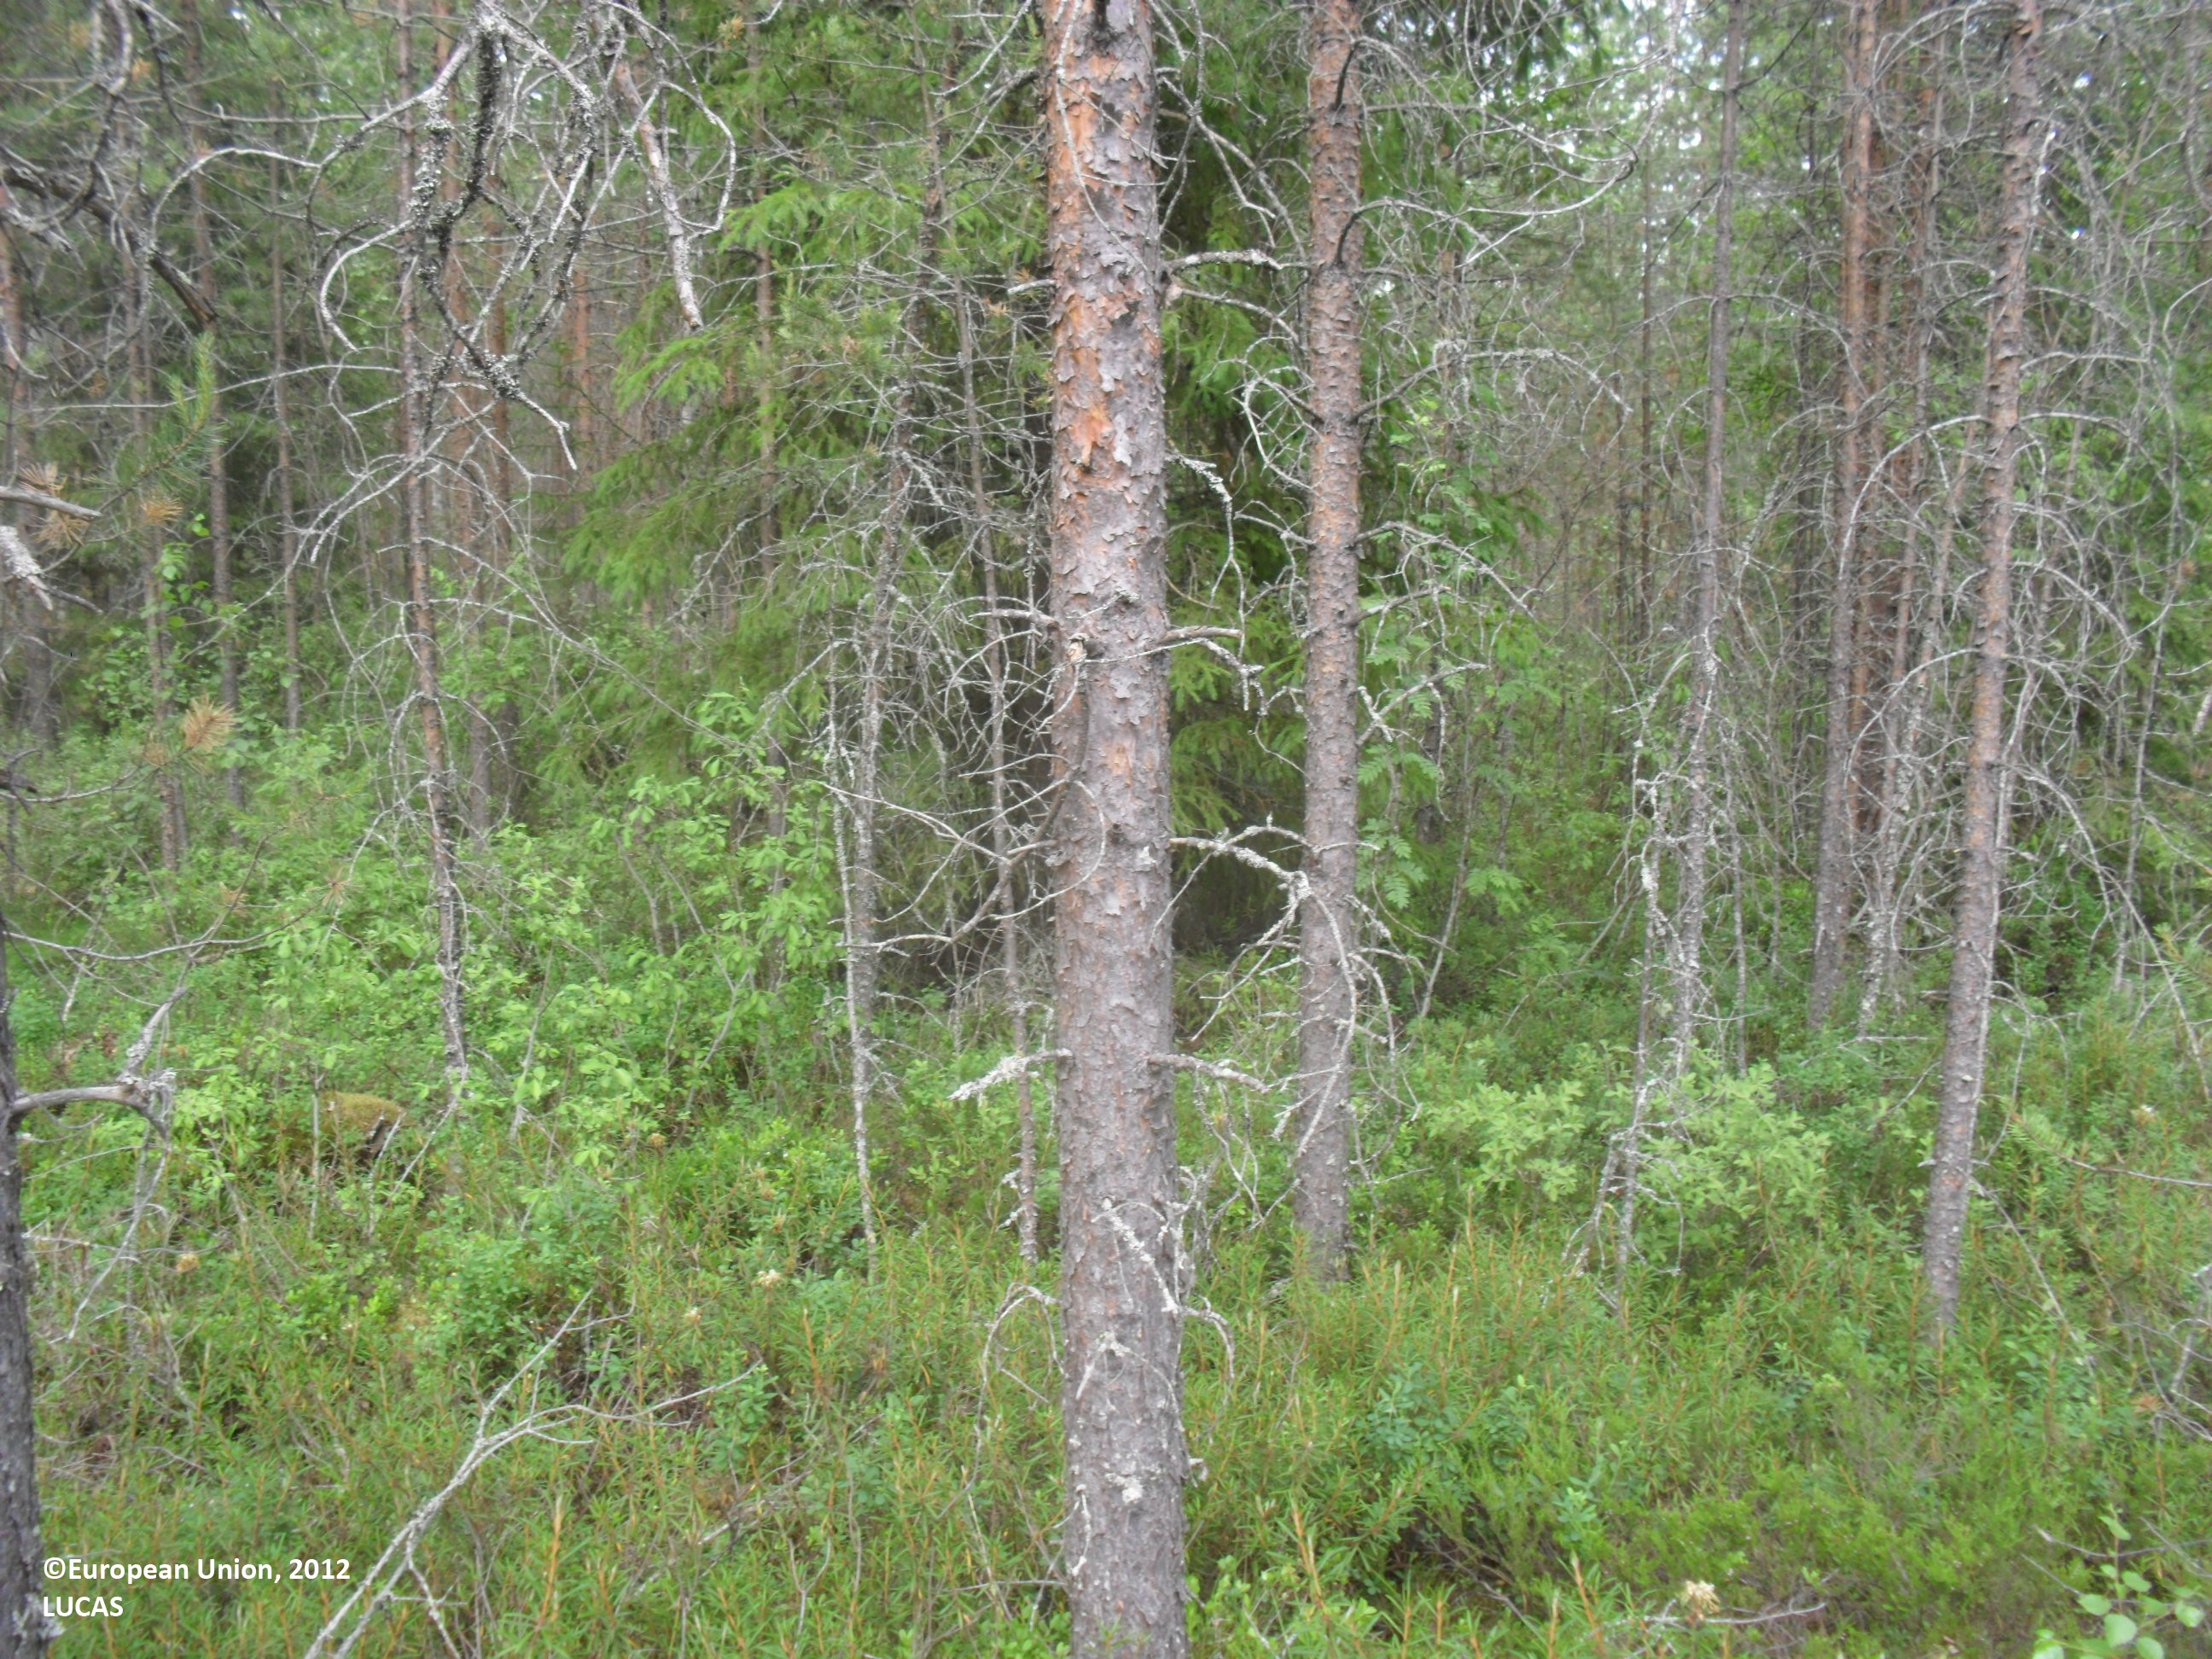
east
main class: Woodland
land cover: Other mixed woodland
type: boreal forest
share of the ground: 25 - 50 %
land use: Forestry
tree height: > 5 m
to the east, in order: Other mixed woodland; Ditches and canals; Spontaneously vegetated surfaces; Pine dominated mixed woodland; Ditches and canals; Pine dominated coniferous woodland; Ditches and canals; Pine dominated coniferous woodland; Ditches and canals; Pine dominated coniferous woodland; Ditches and canals; Pine dominated coniferous woodland
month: July
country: FI
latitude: 63.4916
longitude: 23.8645
